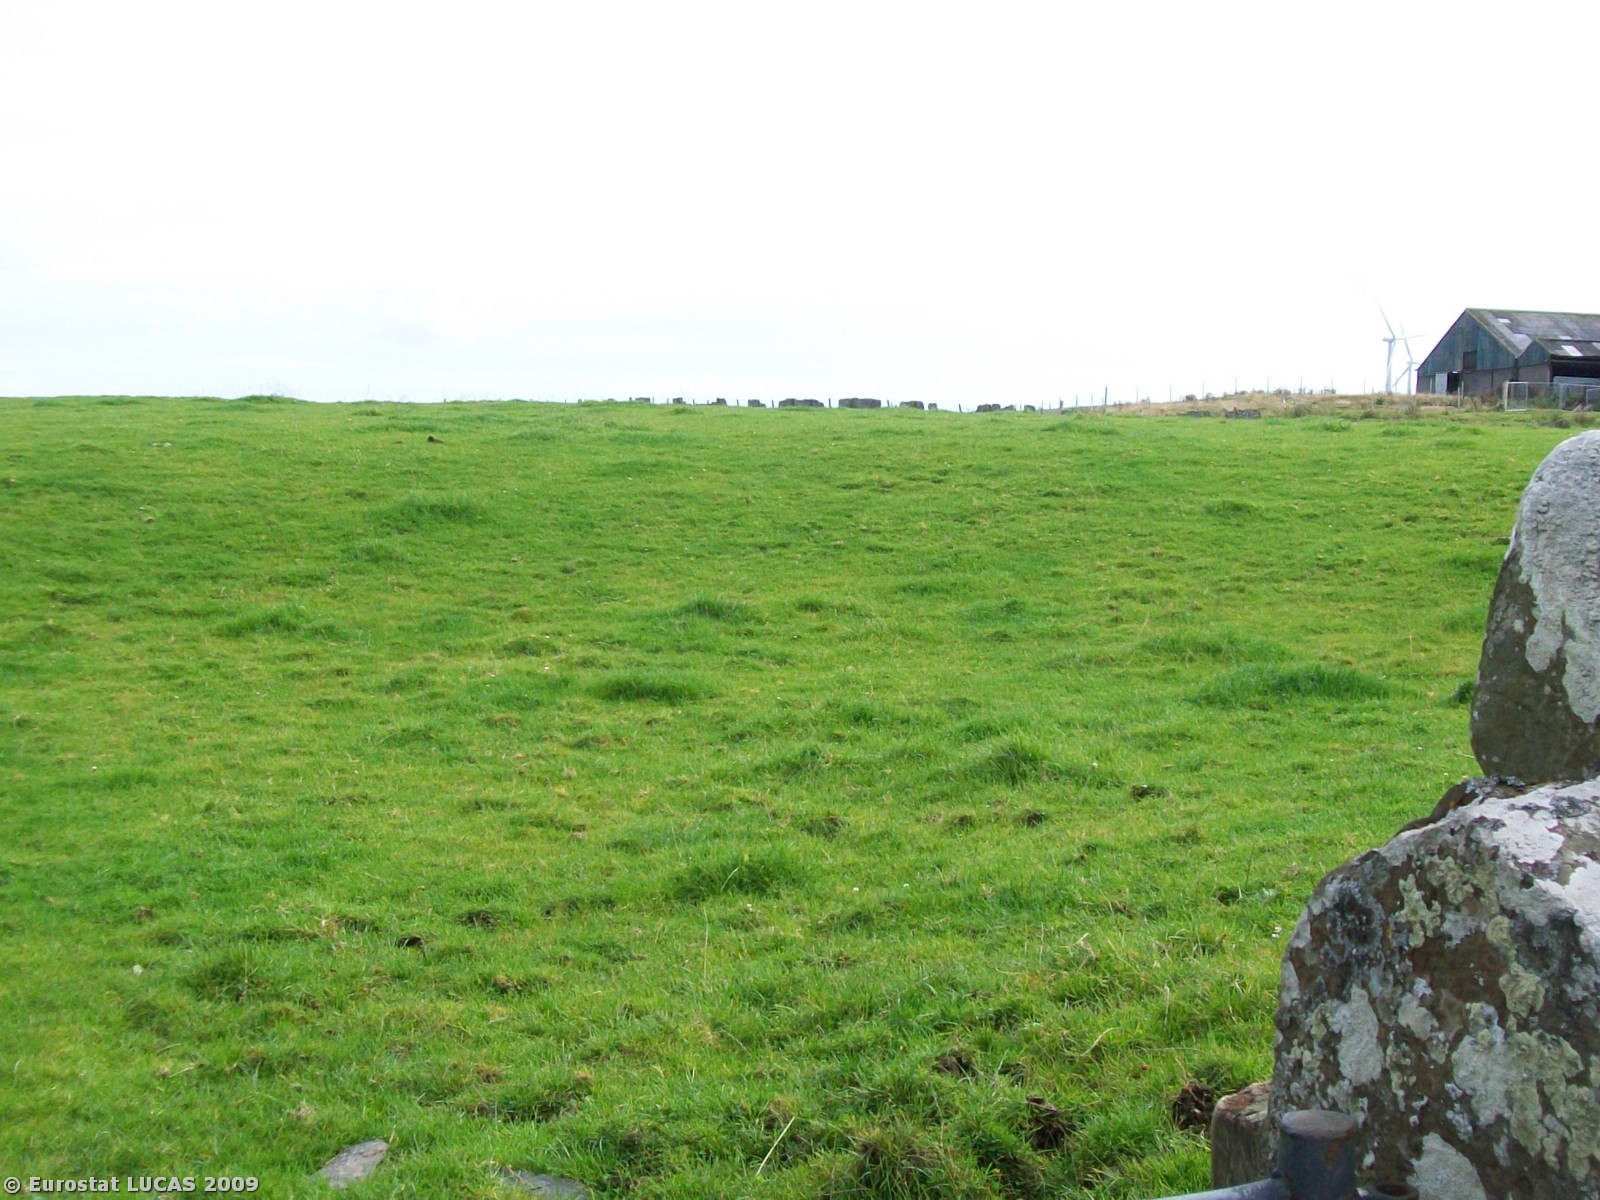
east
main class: Grassland
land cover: Grassland without tree/shrub cover
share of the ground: > 75 %
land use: Agriculture (excluding fallow land and kitchen gardens)
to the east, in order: Grassland without tree/shrub cover; Fences; Grassland without tree/shrub cover; Shruby margins
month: August
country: GB
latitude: 58.4526
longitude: -3.2727
